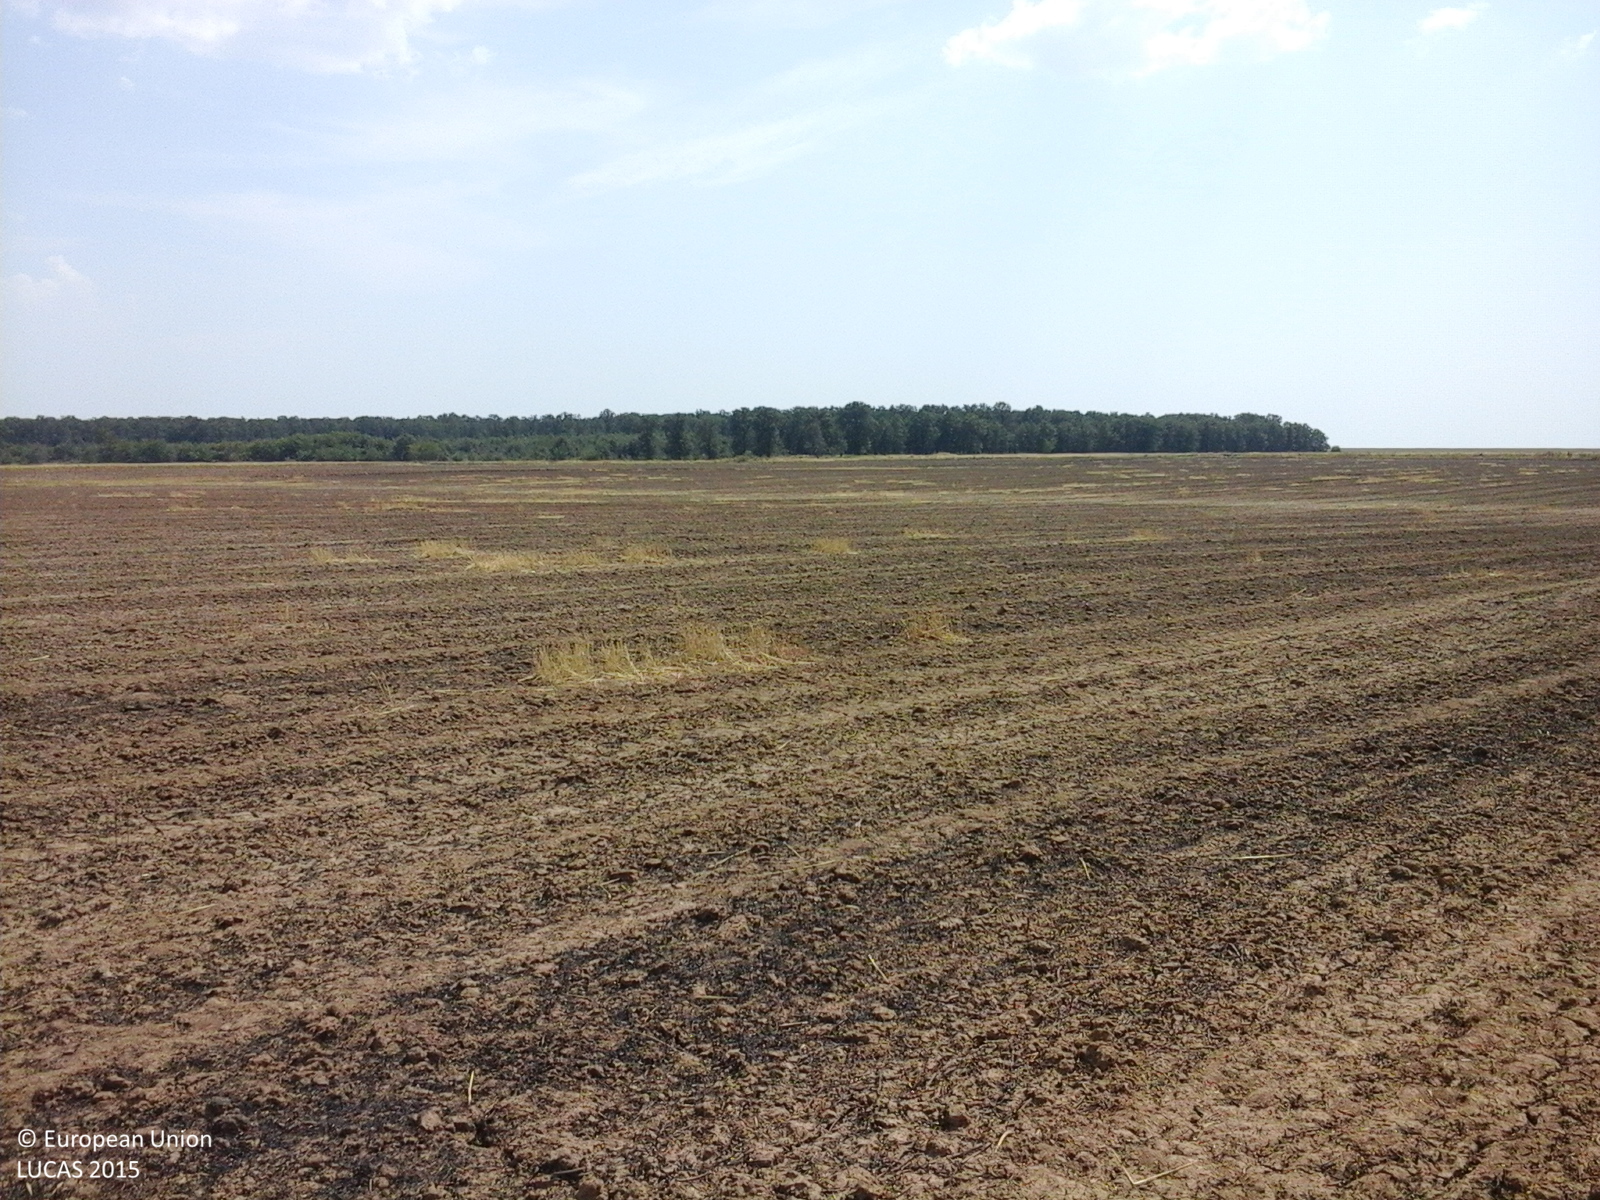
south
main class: Cropland
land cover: Common wheat
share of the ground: < 10 %
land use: Agriculture (excluding fallow land and kitchen gardens)
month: August
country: RO
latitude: 44.2599
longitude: 23.1349
